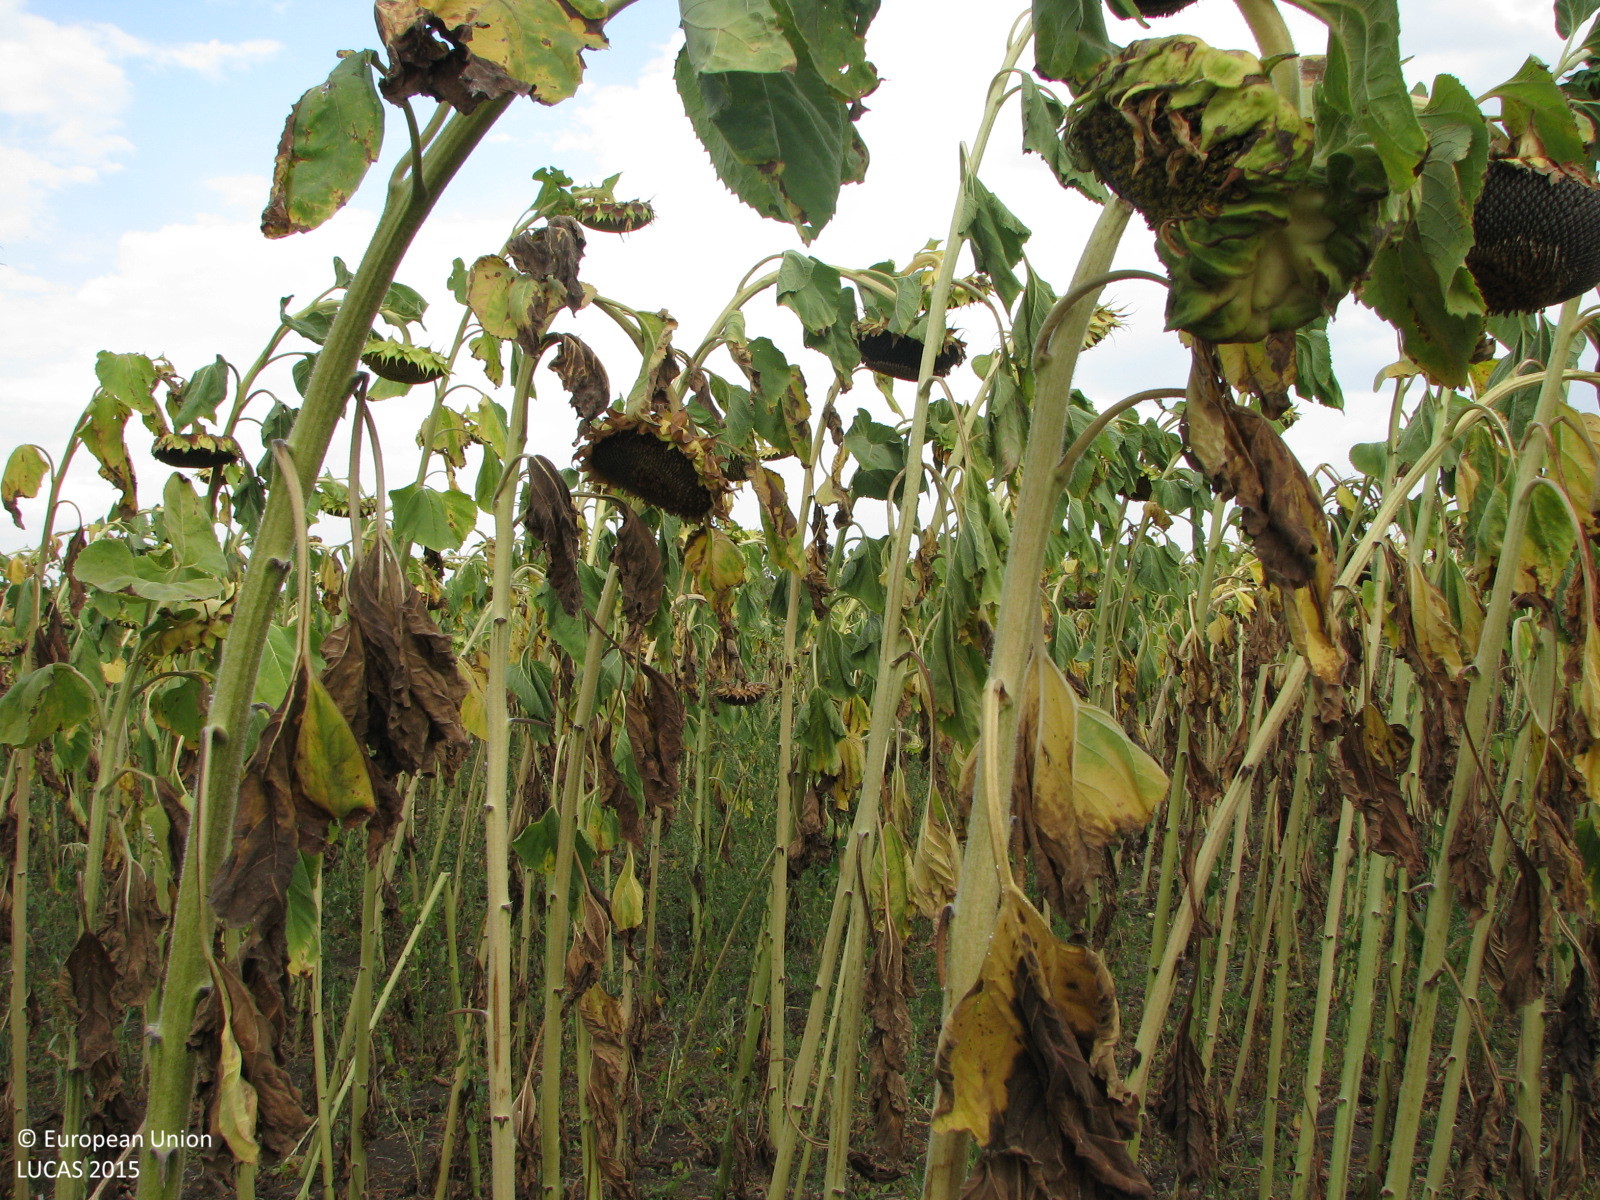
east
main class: Cropland
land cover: Sunflower
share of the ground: > 75 %
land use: Agriculture (excluding fallow land and kitchen gardens)
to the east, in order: Sunflower; Grass margins; Common wheat
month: August
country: BG
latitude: 42.4027
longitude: 26.5552
